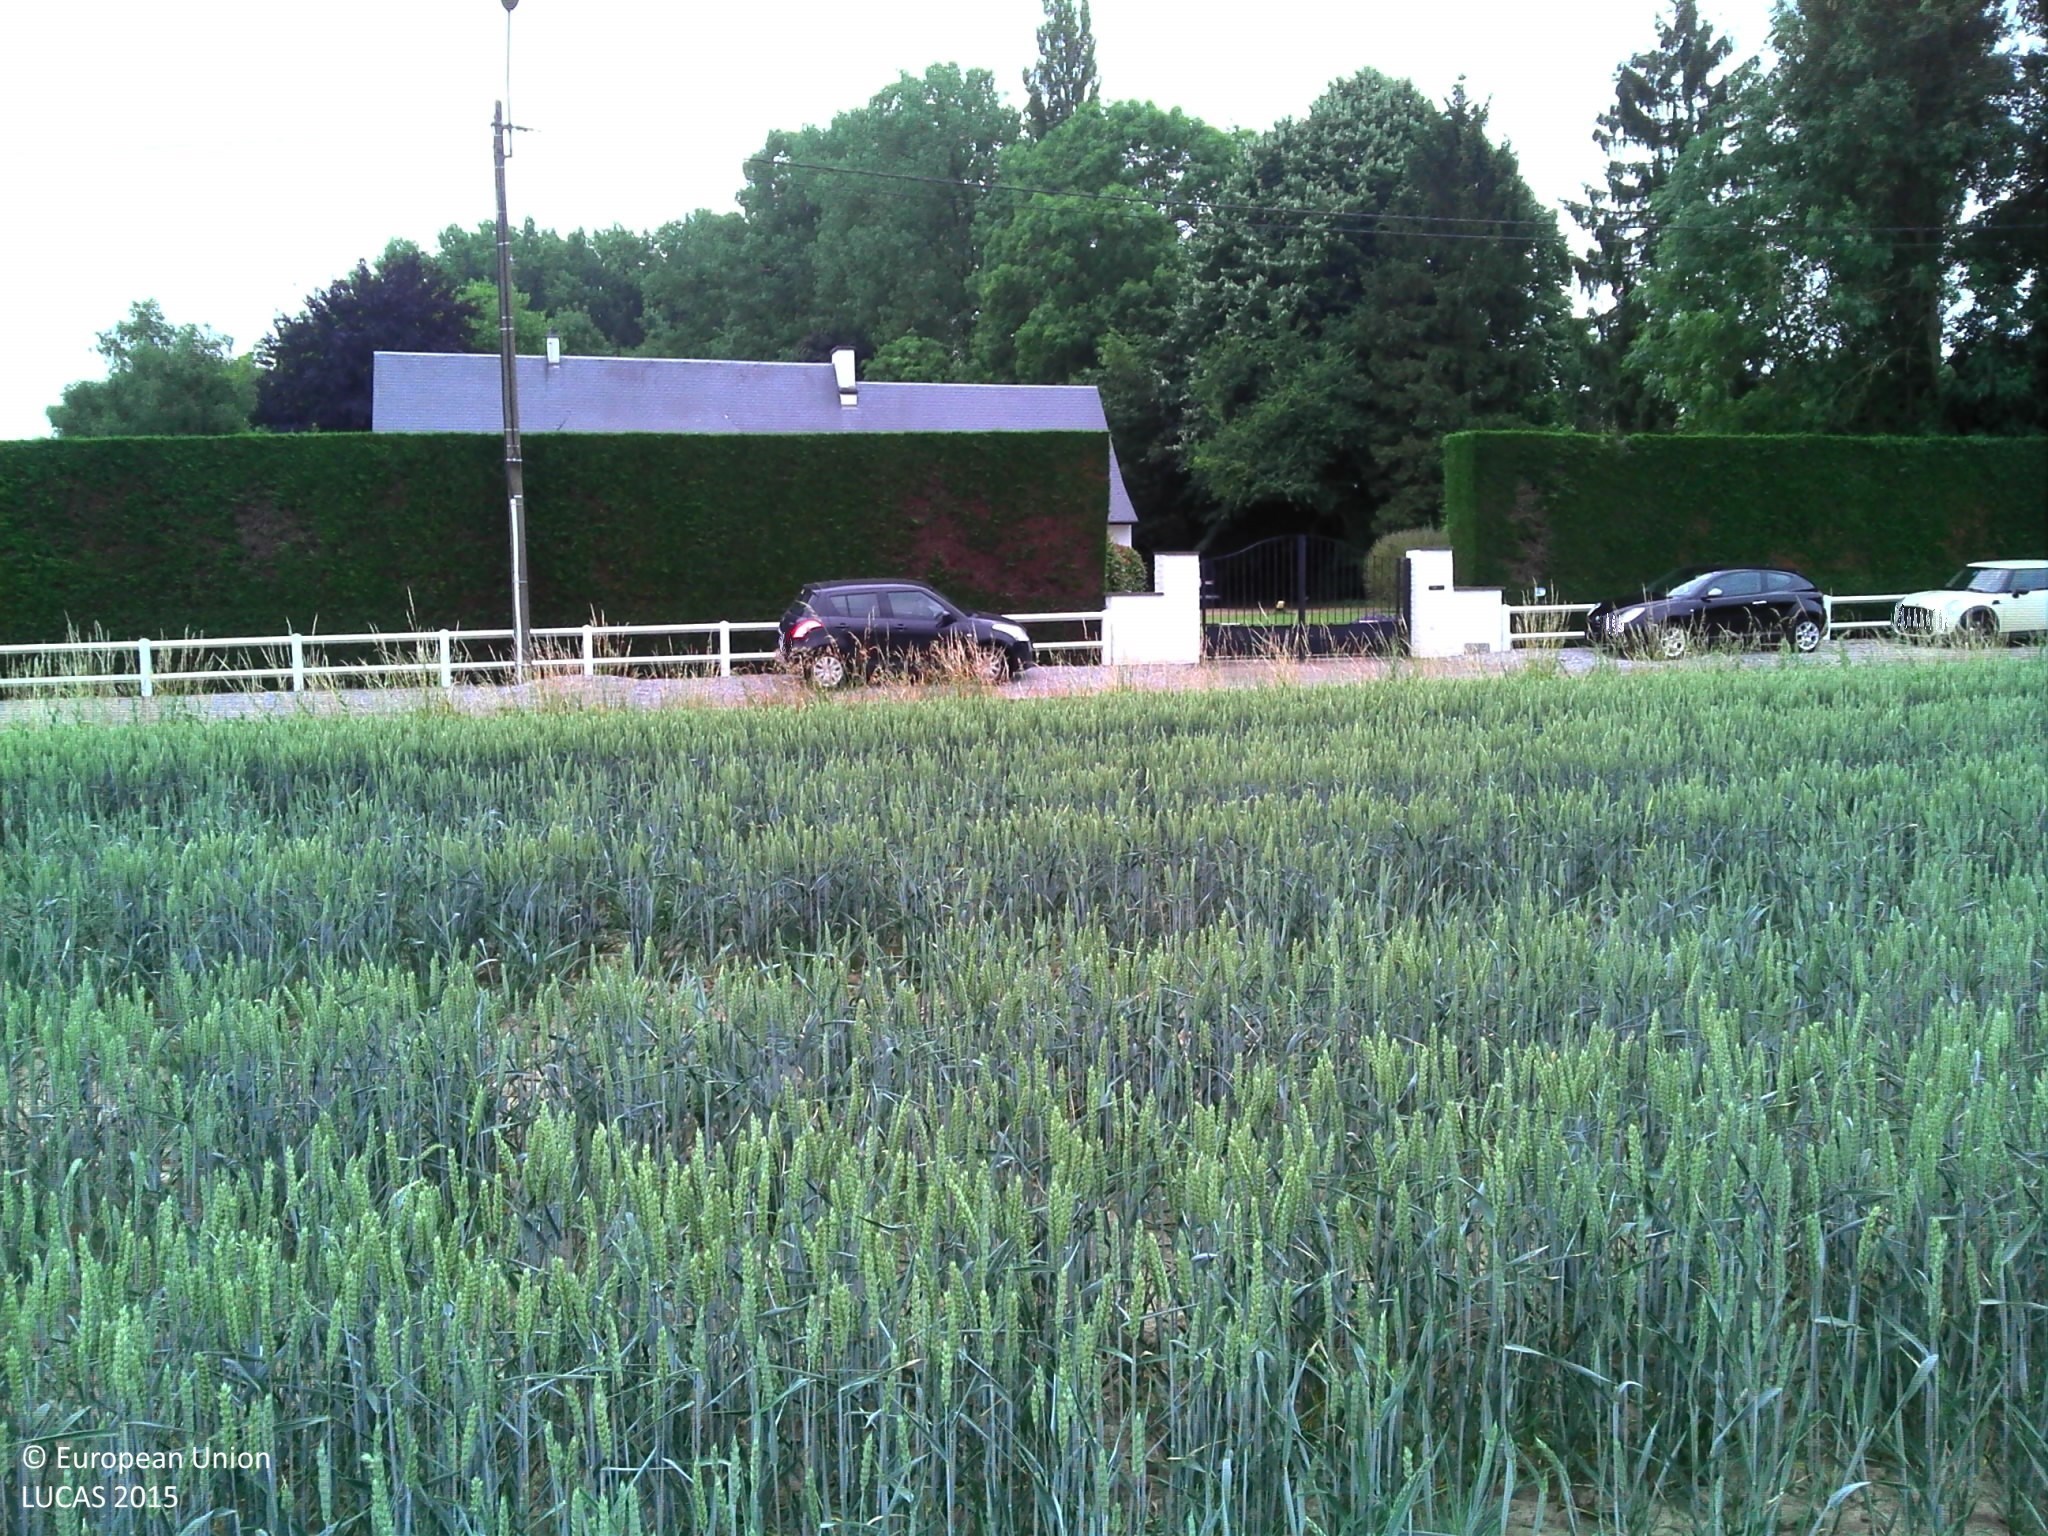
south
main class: Cropland
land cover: Common wheat
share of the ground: > 75 %
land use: Agriculture (excluding fallow land and kitchen gardens)
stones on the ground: < 10 %
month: July
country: BE
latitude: 50.4655
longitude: 4.4874
